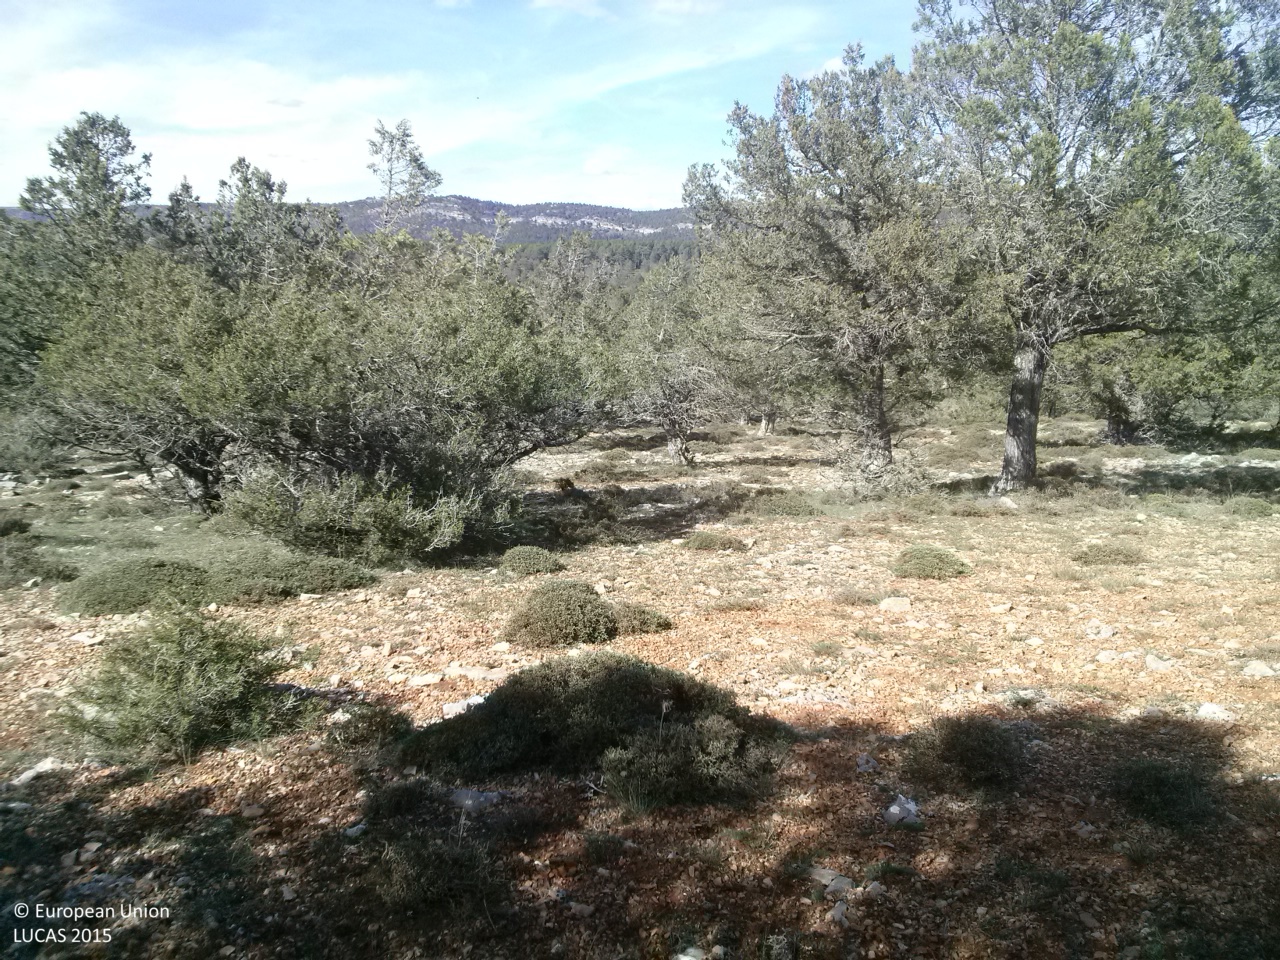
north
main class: Woodland
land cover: Other coniferous woodland
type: coniferous forest of the mediterranean region
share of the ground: 10 - 25 %
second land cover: Grassland without tree/shrub cover
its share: 25 - 50 %
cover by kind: unconsolidated bare surface 50 %, herbaceous plants 30 %, coniferous forest trees 15 %, shrubs 5 %
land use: Forestry
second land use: Agriculture (excluding fallow land and kitchen gardens)
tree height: < 5 m
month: April
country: ES
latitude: 40.0963
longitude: -1.6833
